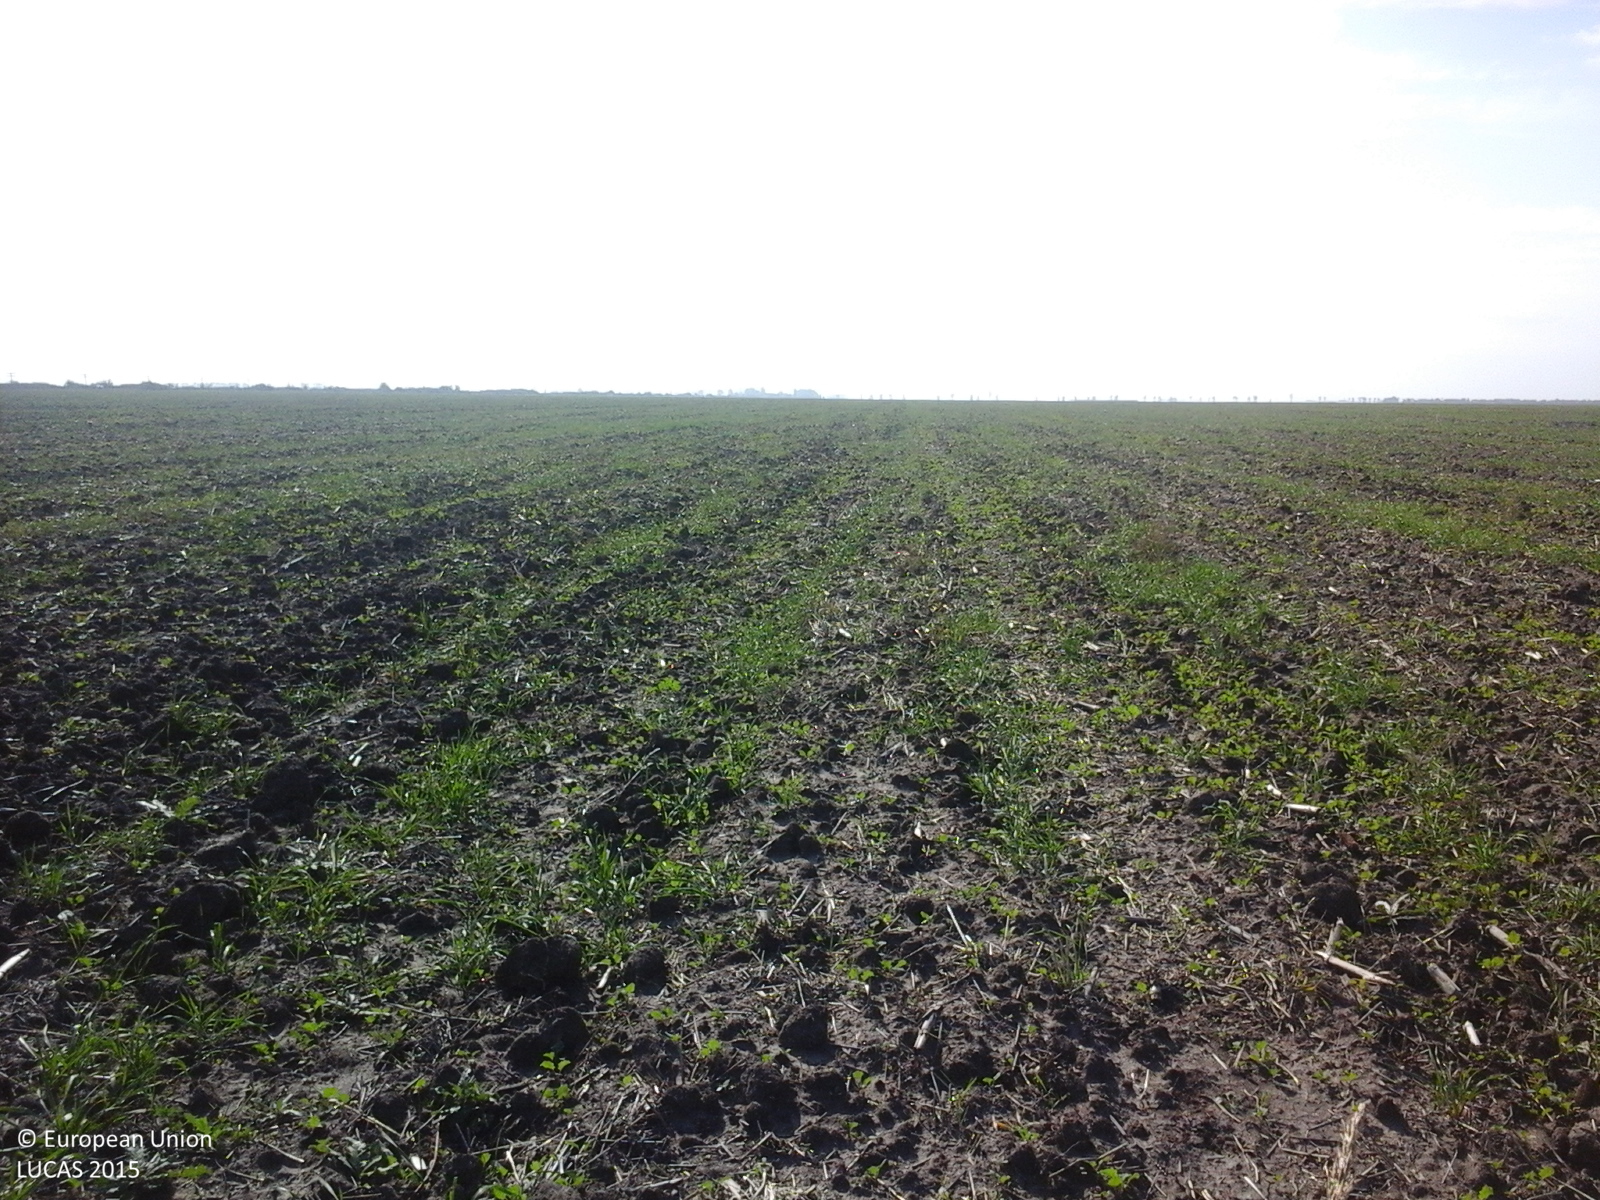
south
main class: Cropland
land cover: Rape and turnip rape
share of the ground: 10 - 25 %
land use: Agriculture (excluding fallow land and kitchen gardens)
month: October
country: RO
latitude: 45.3529
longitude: 27.2885
